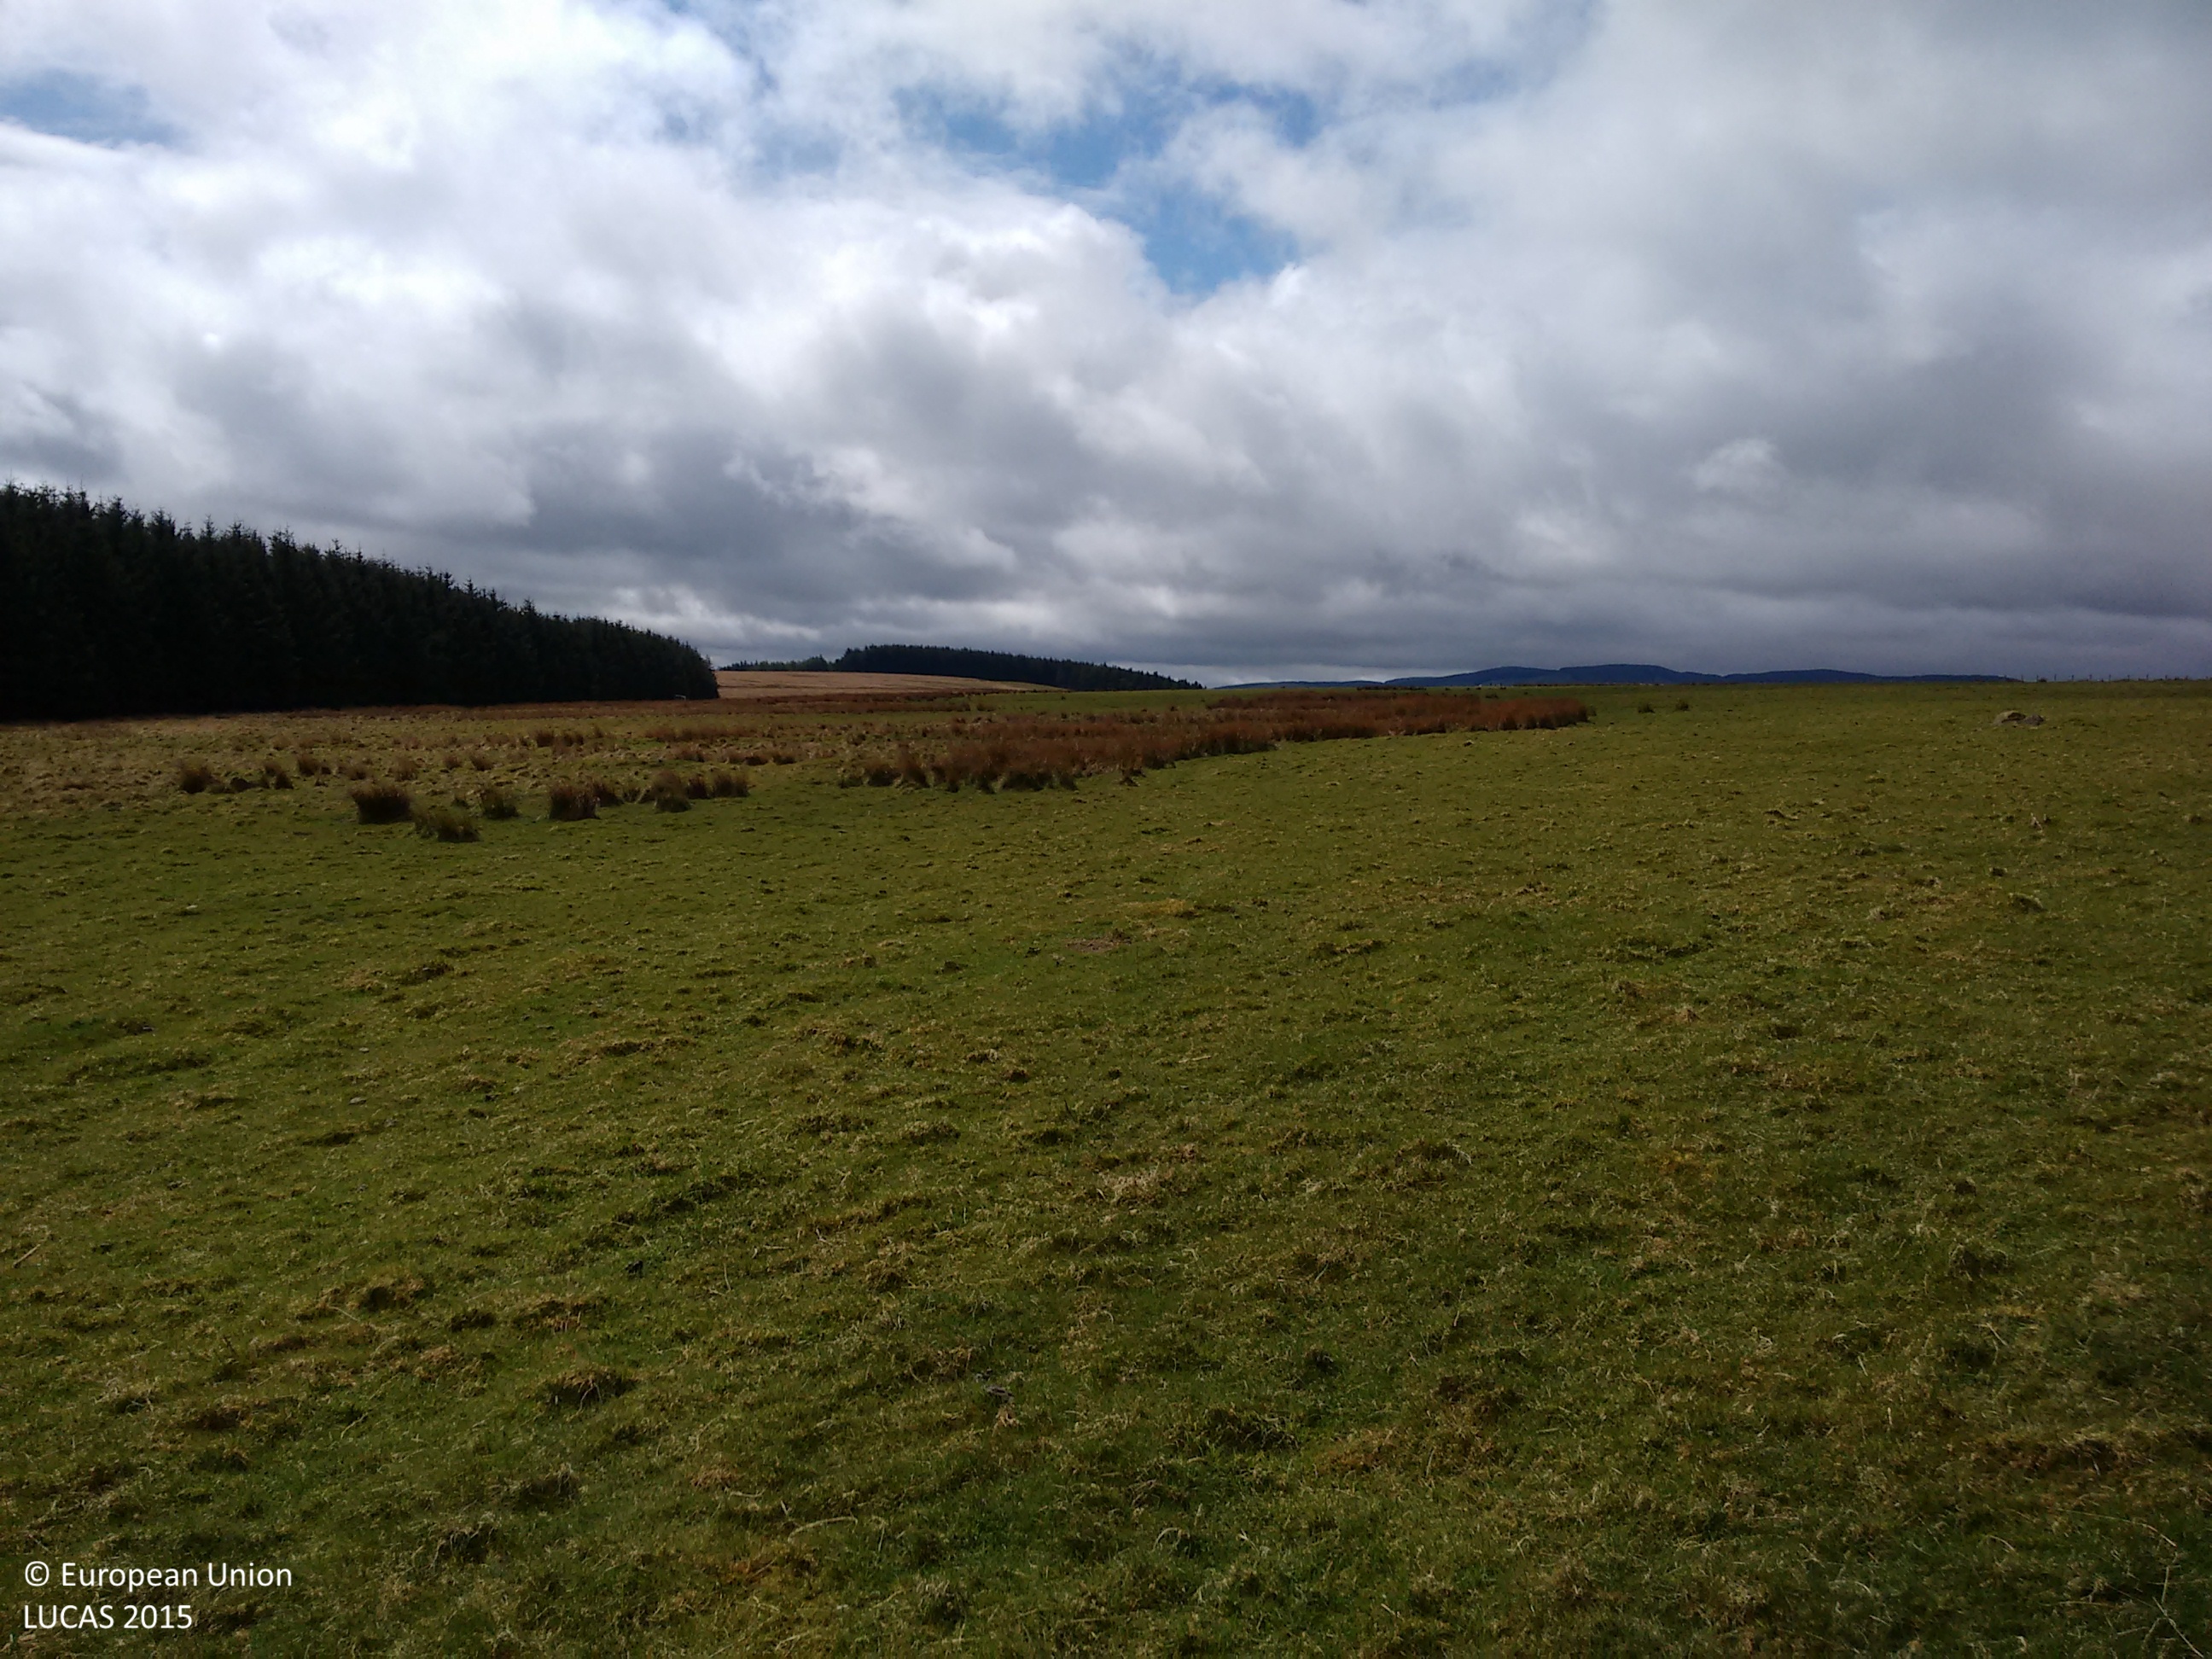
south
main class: Grassland
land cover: Grassland without tree/shrub cover
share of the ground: > 75 %
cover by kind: herbaceous plants 100 %
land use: Agriculture (excluding fallow land and kitchen gardens)
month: May
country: GB
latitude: 55.7763
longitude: -3.1930
